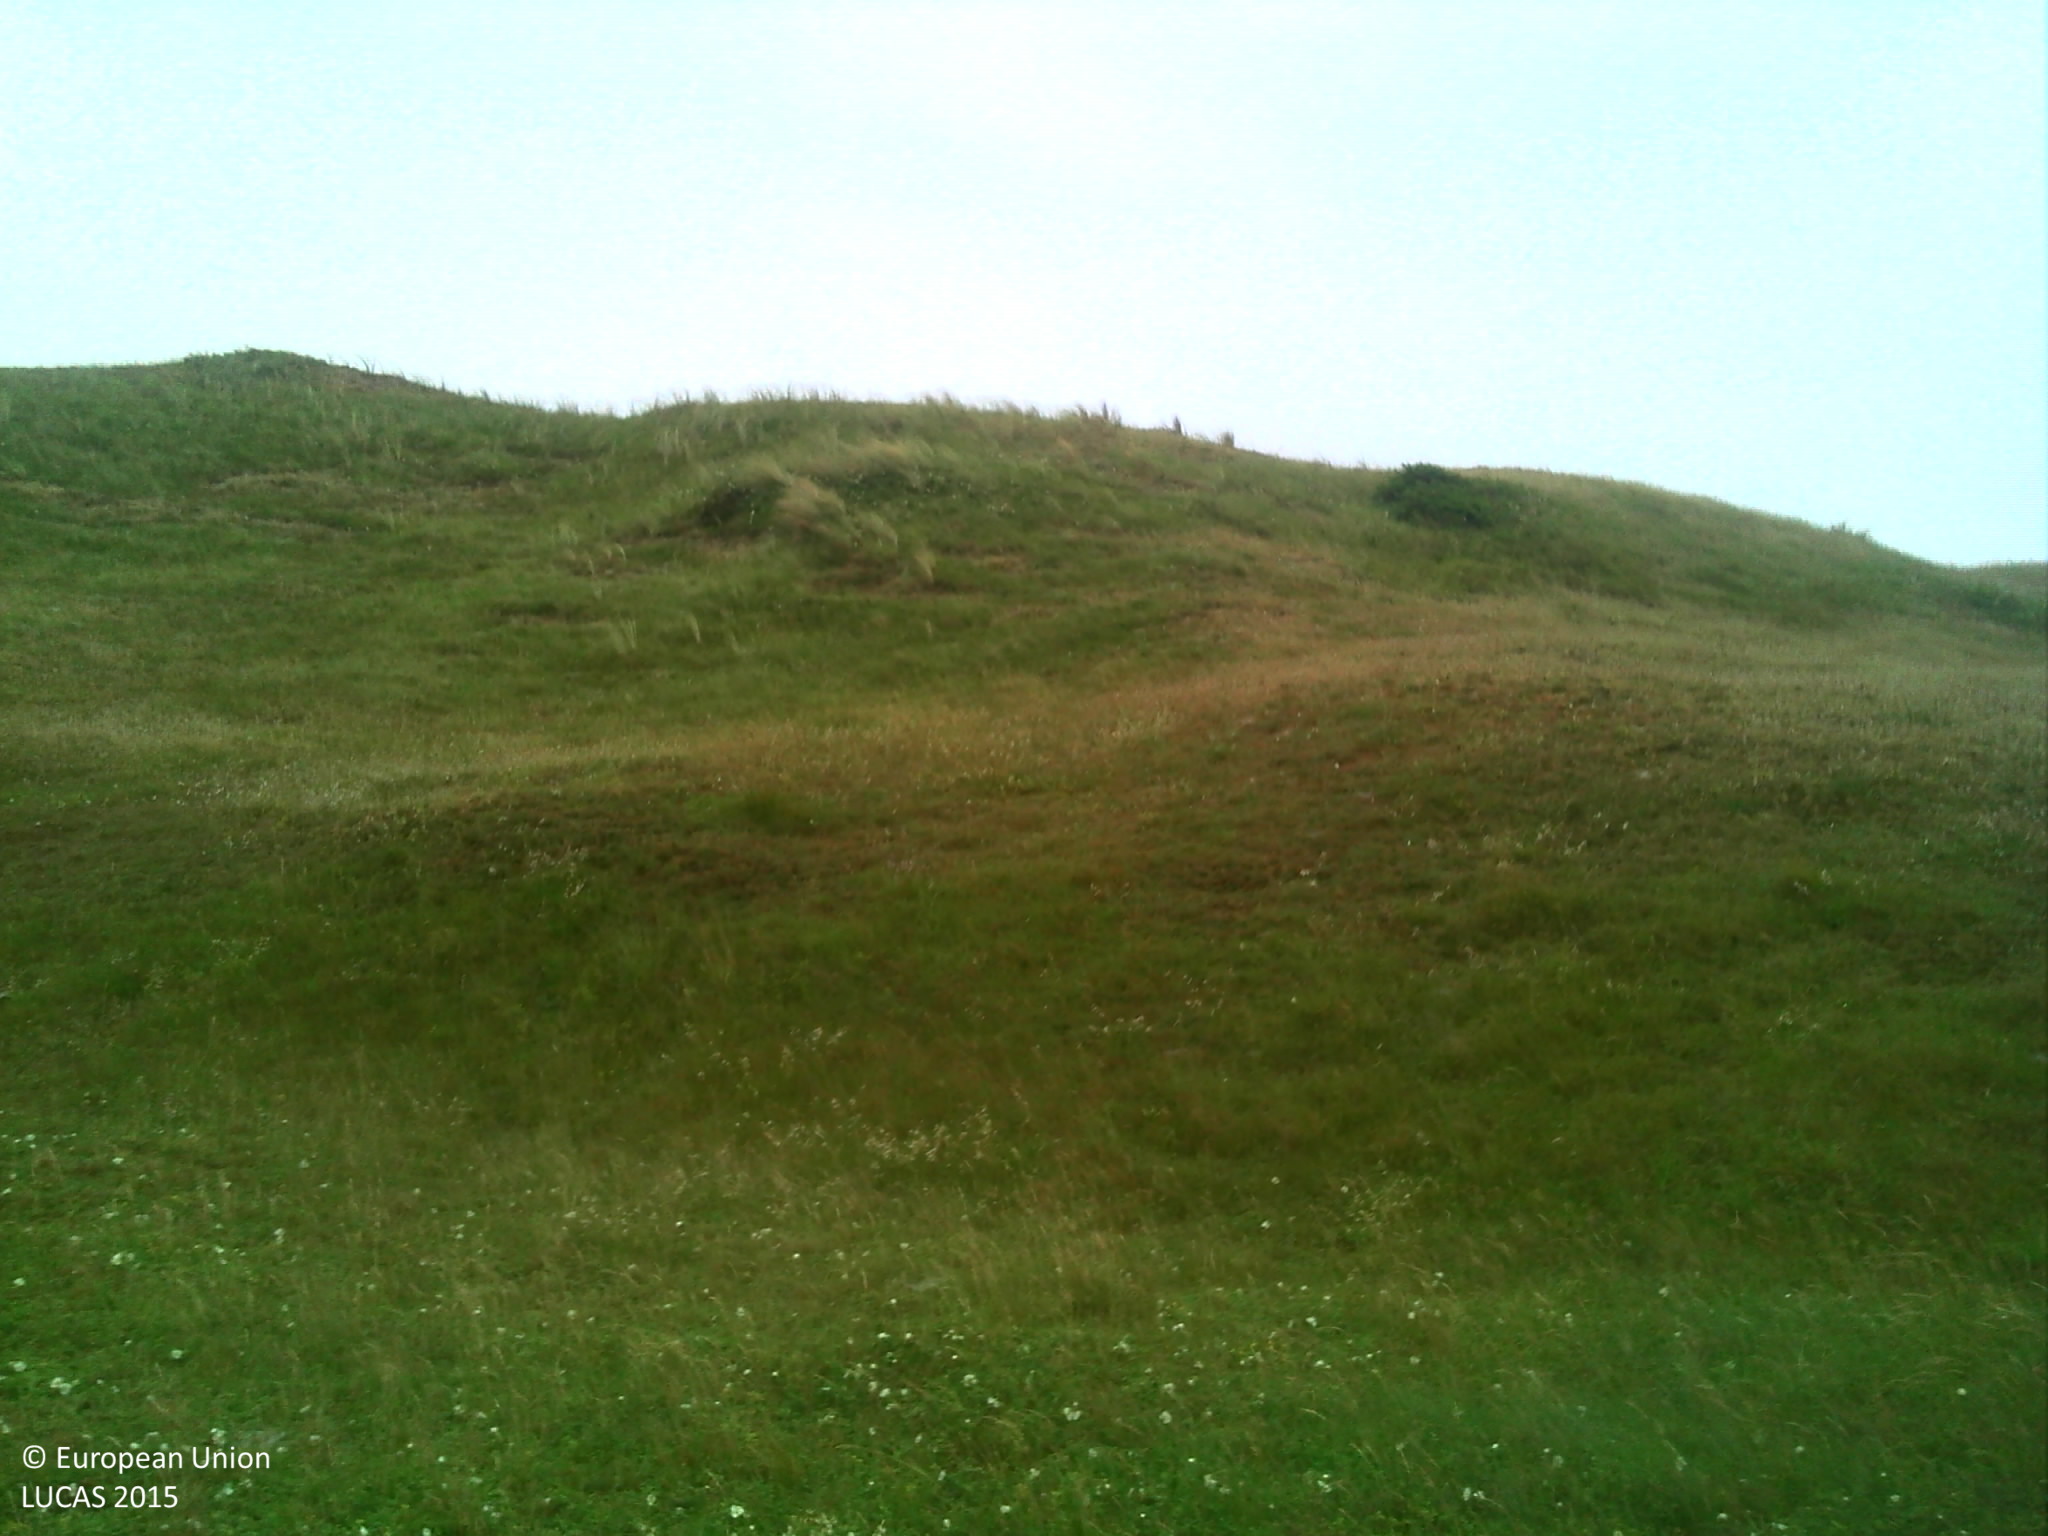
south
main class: Grassland
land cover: Spontaneously vegetated surfaces
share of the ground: > 75 %
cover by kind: herbaceous plants 100 %
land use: Semi-natural and natural areas not in use
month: June
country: FR
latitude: 49.6022
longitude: -1.8295
